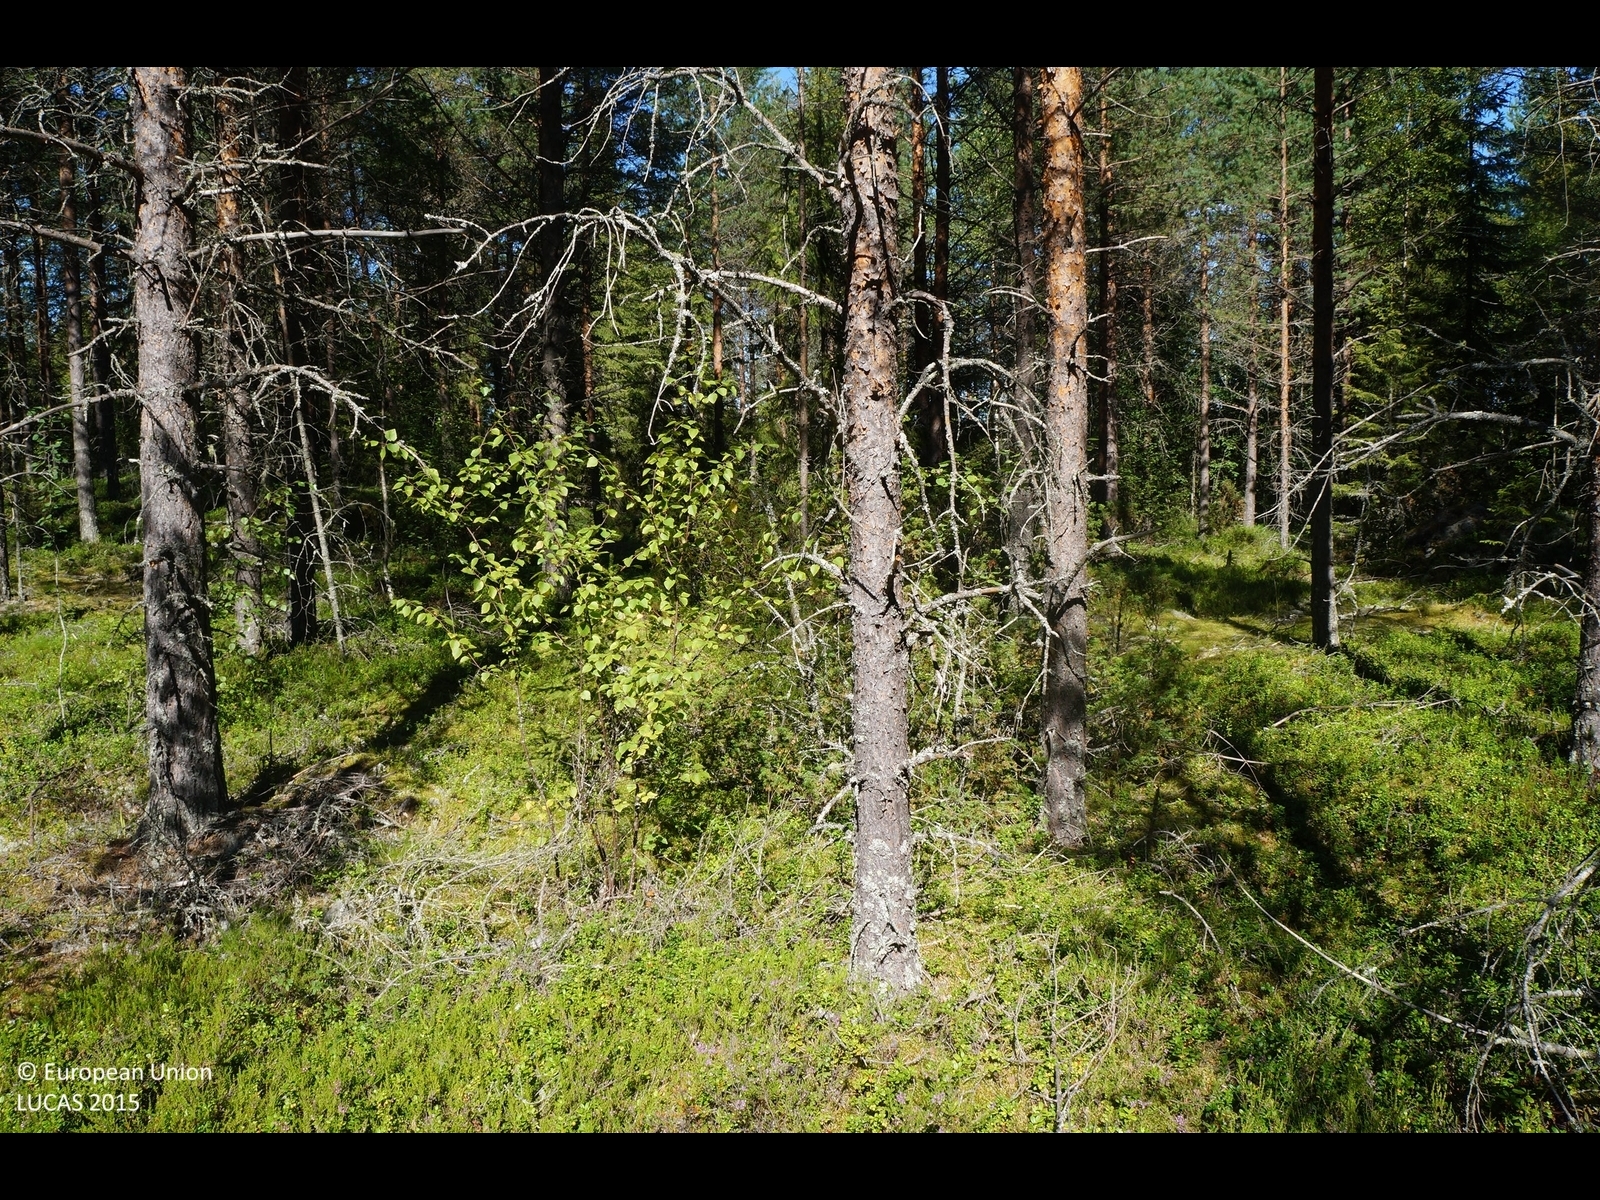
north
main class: Woodland
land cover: Pine dominated coniferous woodland
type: boreal forest
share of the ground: 50 - 75 %
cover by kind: coniferous forest trees 60 %, shrubs 30 %, lichens and mosses 10 %
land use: Forestry
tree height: > 5 m
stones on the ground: < 10 %
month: August
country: FI
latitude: 64.5961
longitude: 24.6748
